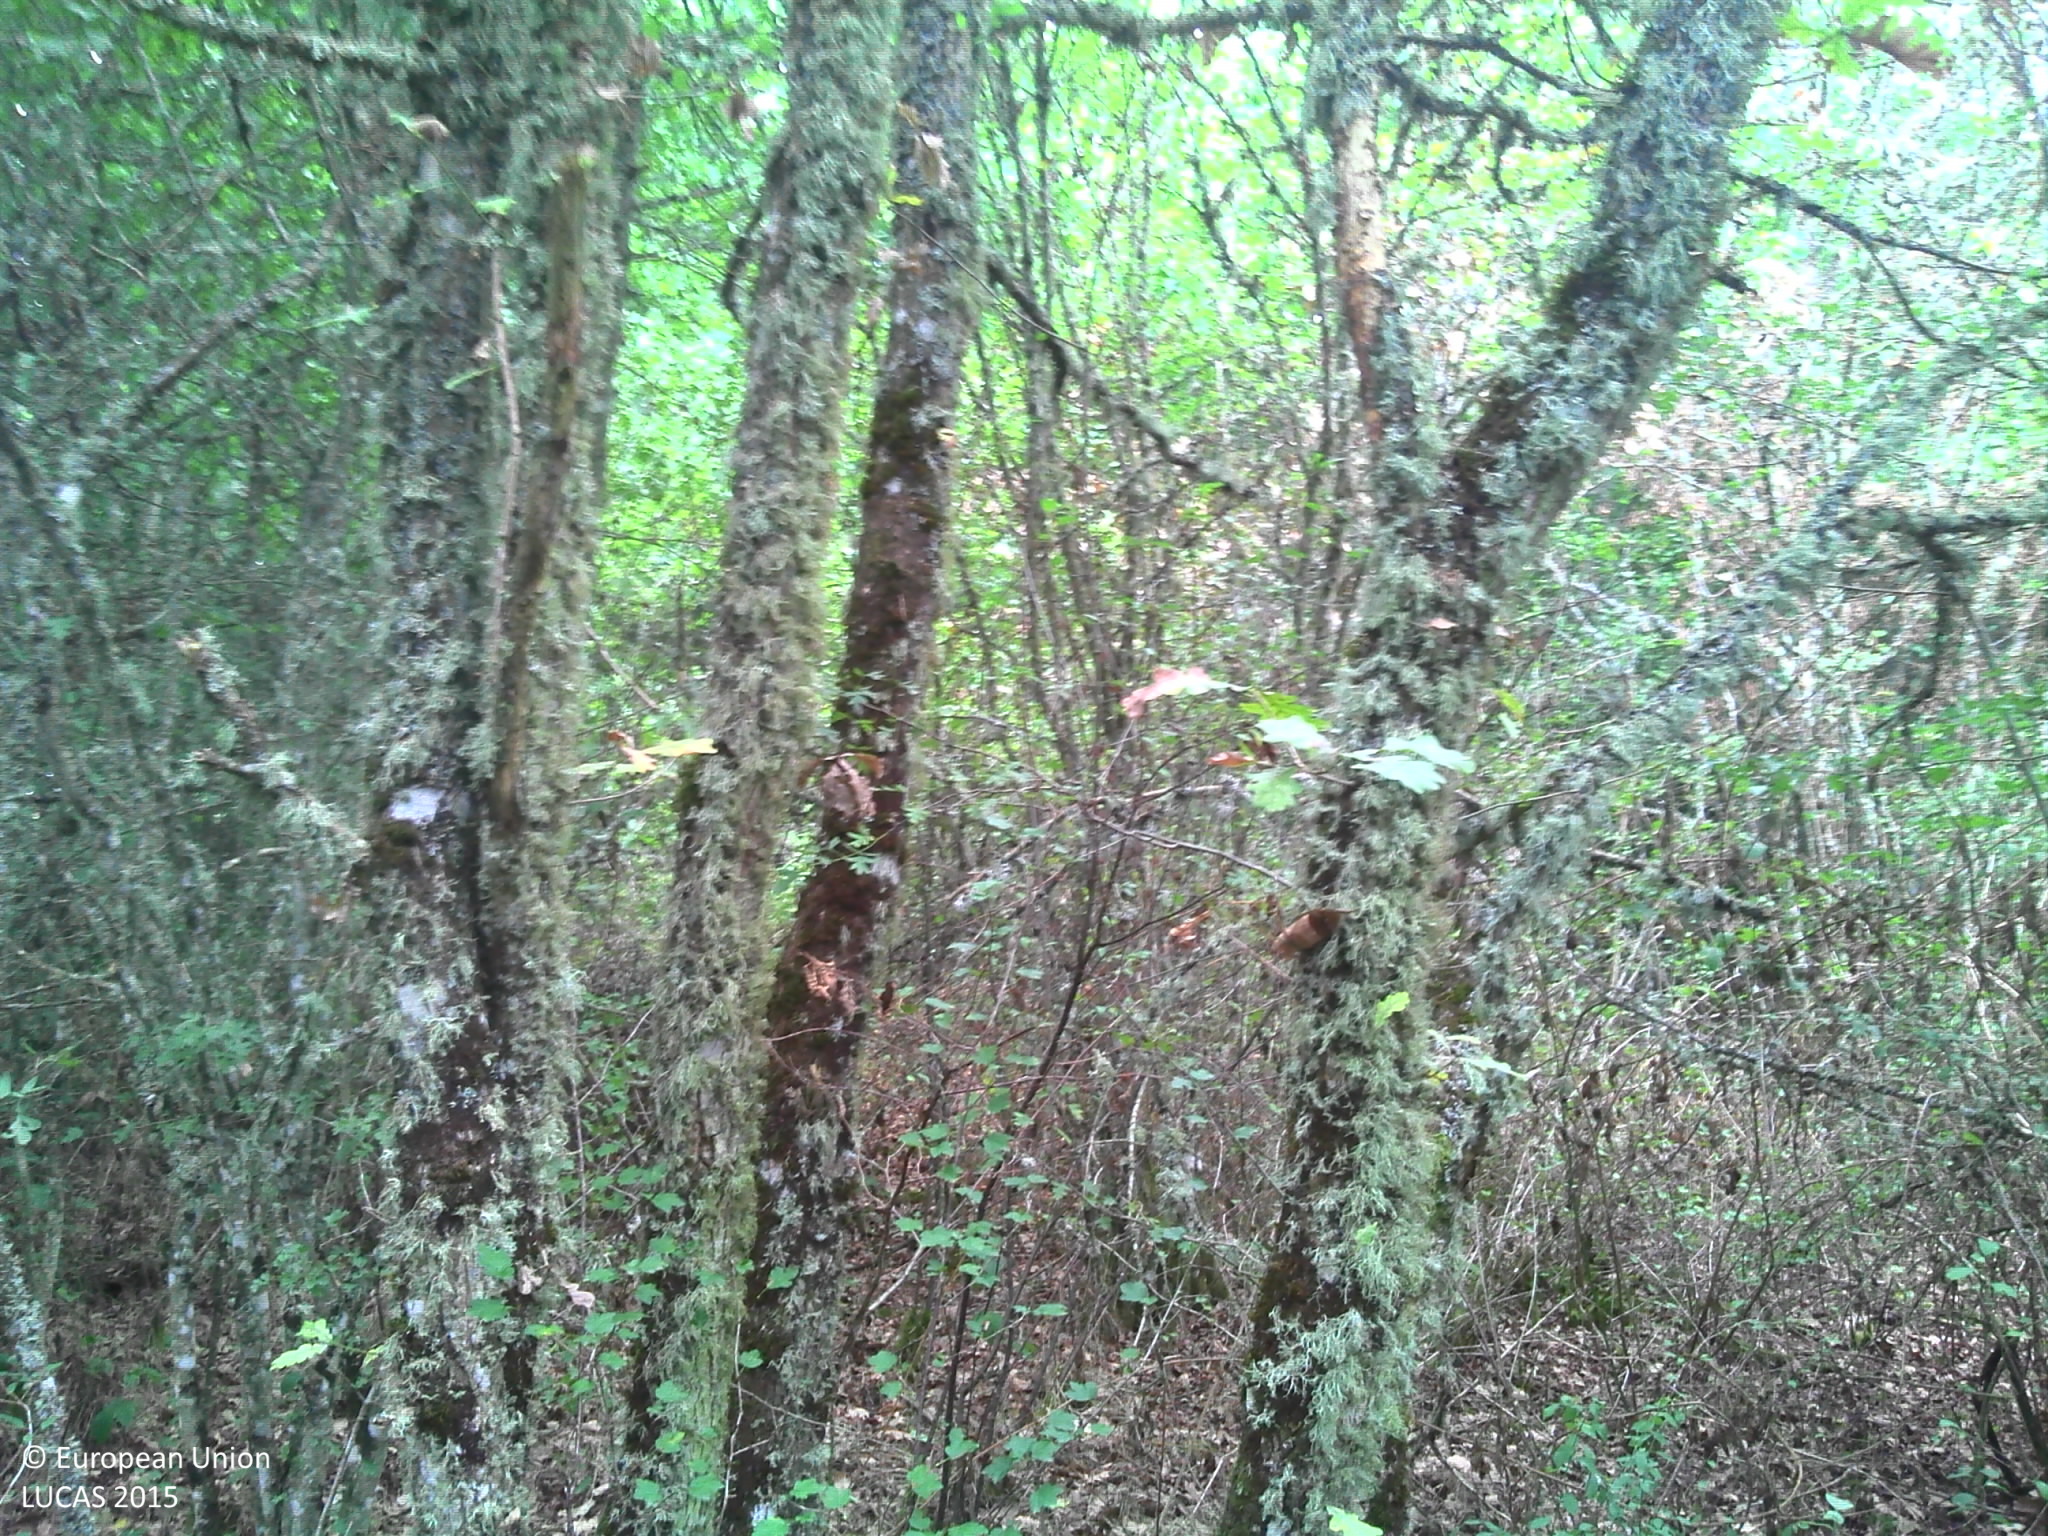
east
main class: Woodland
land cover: Broadleaved woodland
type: acidophilous oak and oak-birch forest
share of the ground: > 75 %
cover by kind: broadleaved forest trees 80 %, shrubs 10 %, herbaceous plants 10 %
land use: Forestry
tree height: > 5 m
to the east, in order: Broadleaved woodland; Grassland with sparse tree/shrub cover; Dry stone walls; Grassland without tree/shrub cover; Artificial constructions in urban areas; Grassland without tree/shrub cover; Fences; Broadleaved woodland; Dry stone walls; Grassland without tree/shrub cover
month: August
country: FR
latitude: 46.0001
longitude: 2.2870
